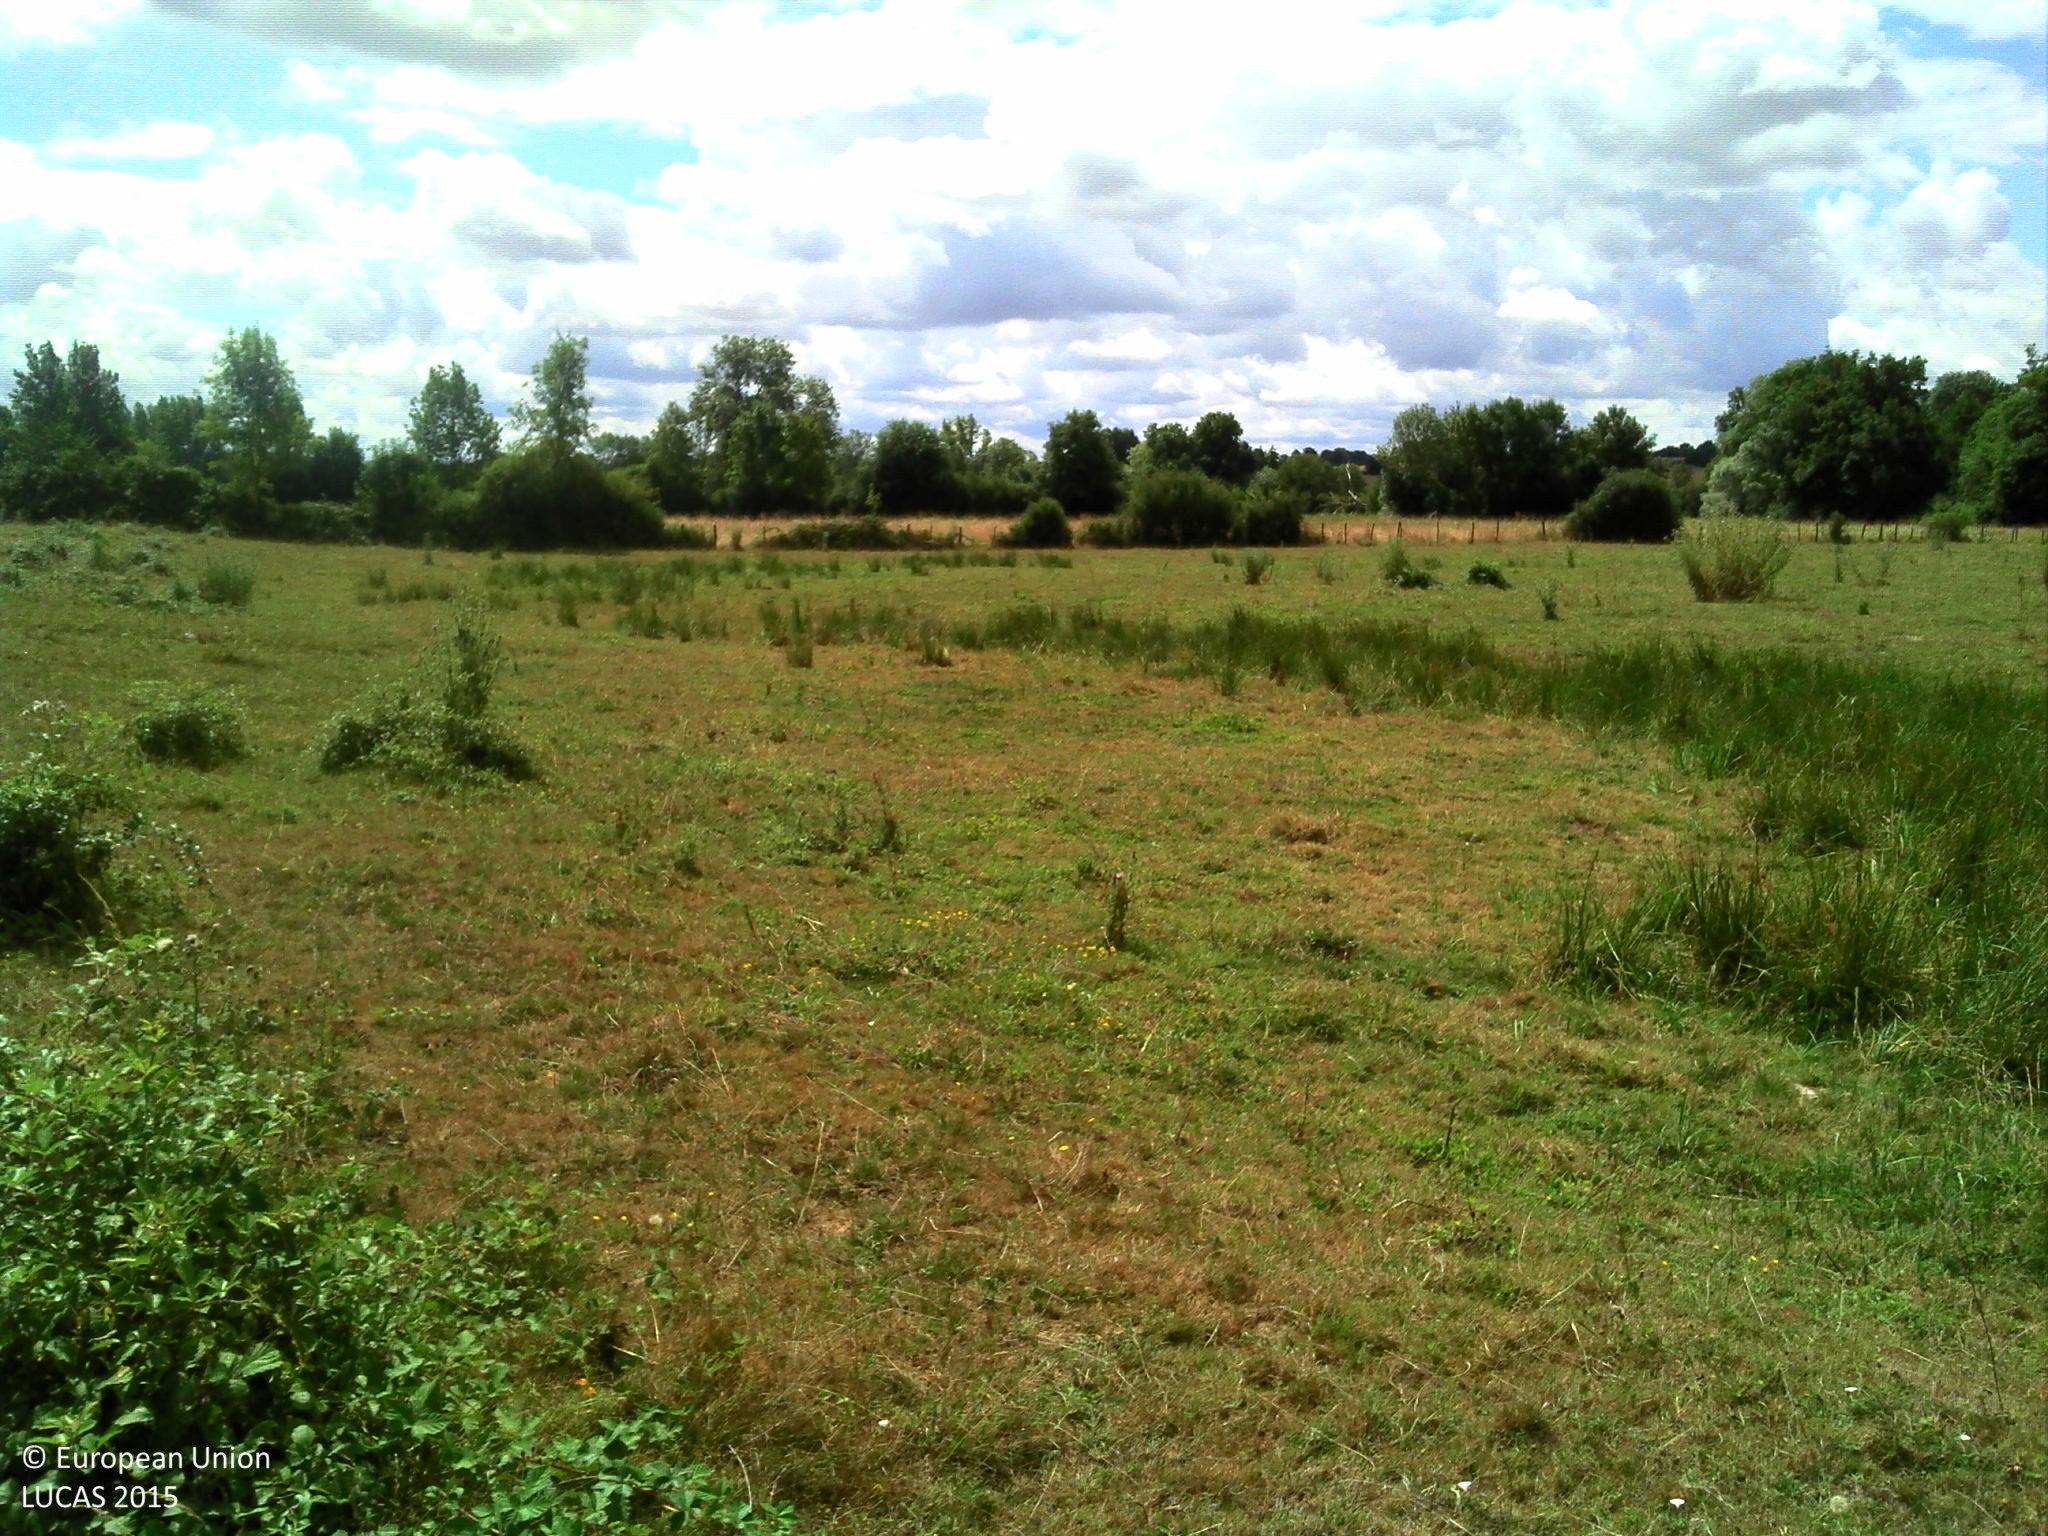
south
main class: Grassland
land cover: Grassland without tree/shrub cover
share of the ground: > 75 %
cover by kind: herbaceous plants 100 %
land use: Agriculture (excluding fallow land and kitchen gardens)
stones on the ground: < 10 %
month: July
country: FR
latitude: 46.7161
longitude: 2.1828
